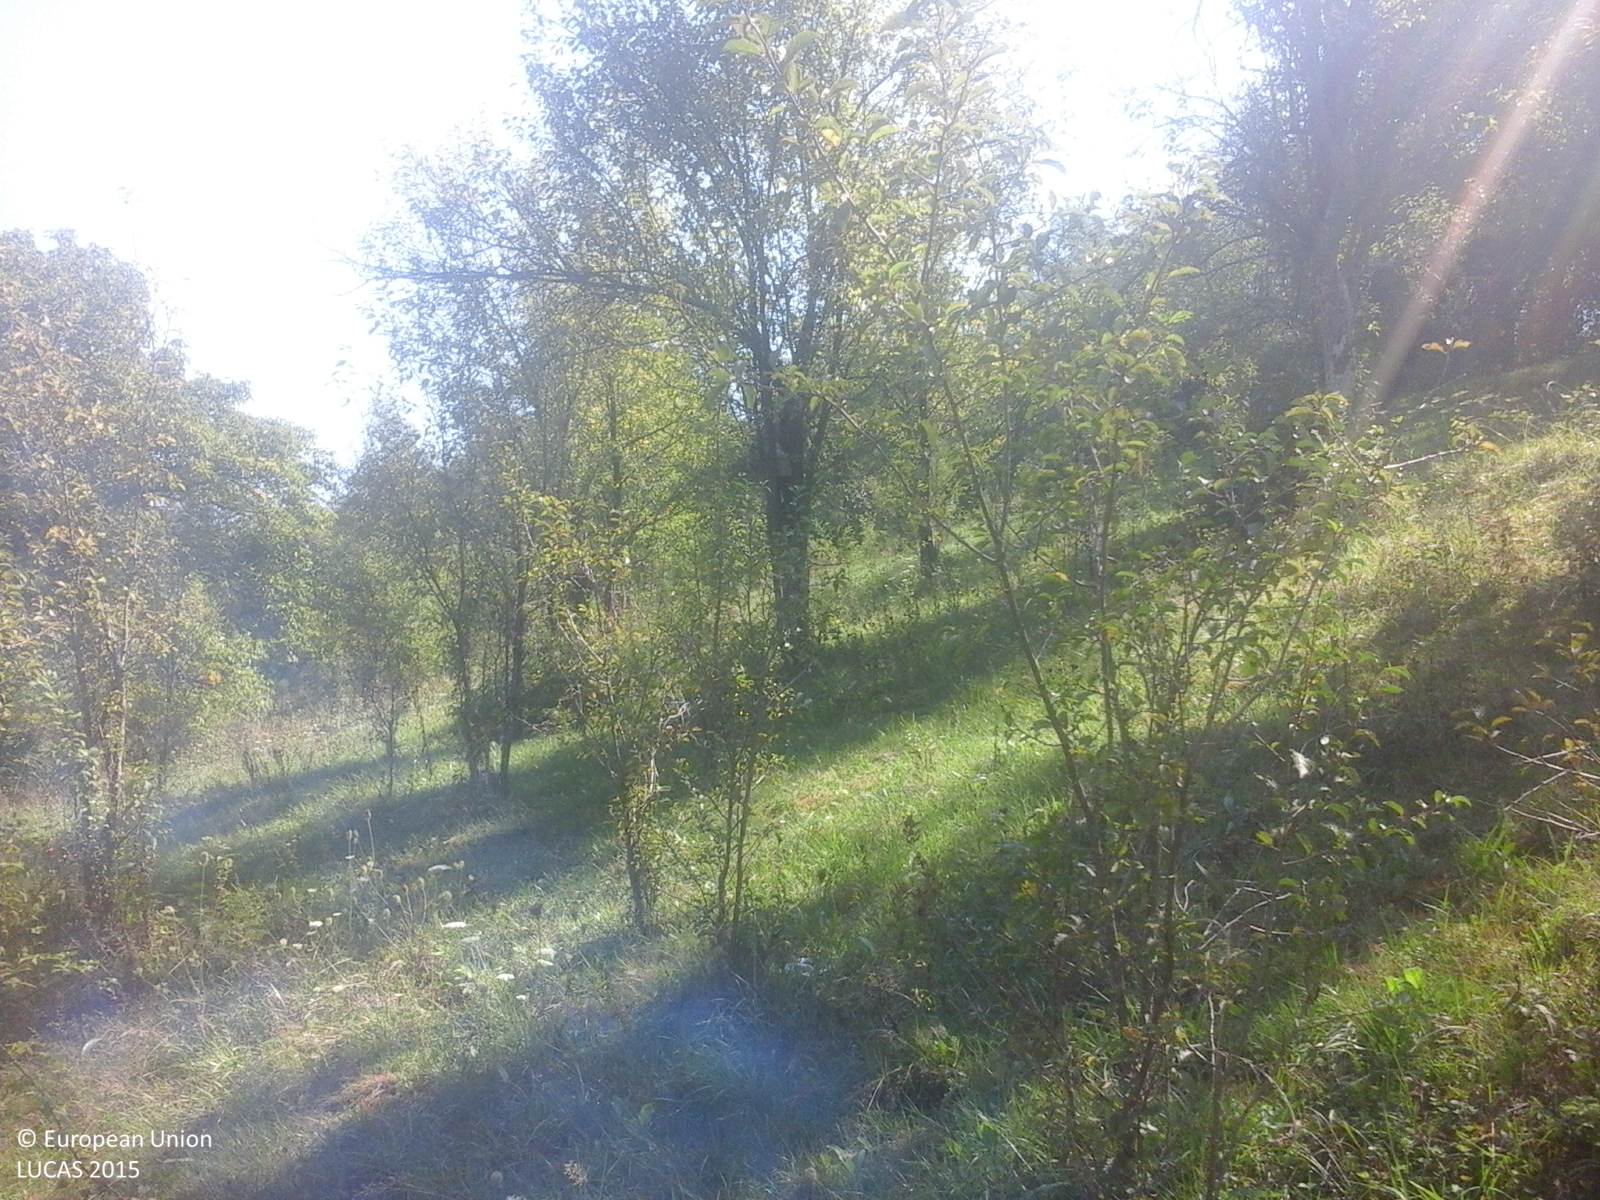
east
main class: Cropland
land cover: Other fruit trees and berries
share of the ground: > 75 %
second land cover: Grassland without tree/shrub cover
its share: > 75 %
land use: Agriculture (excluding fallow land and kitchen gardens)
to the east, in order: Other fruit trees and berries; Grassland without tree/shrub cover; Broadleaved woodland; Tracks; Broadleaved woodland; Tracks
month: August
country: RO
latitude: 46.1324
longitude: 22.4351
